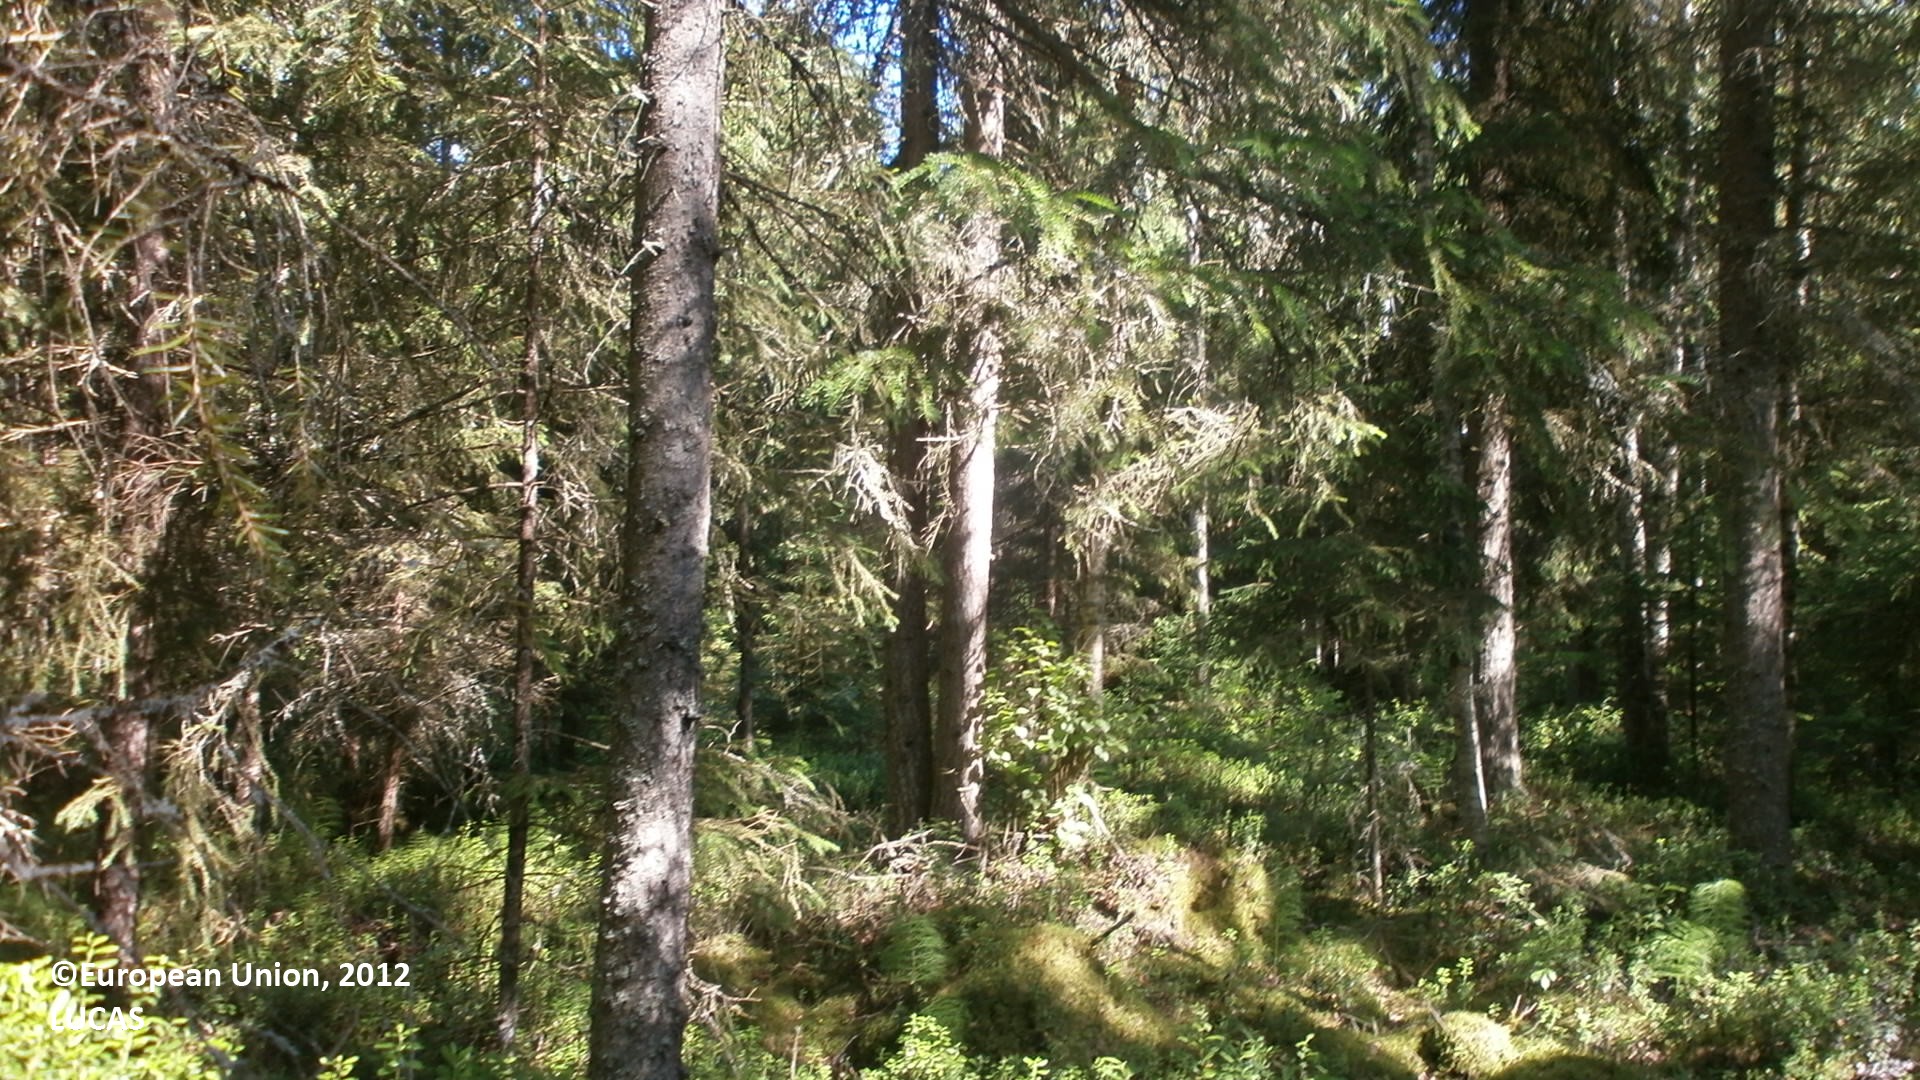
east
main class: Woodland
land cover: Spruce dominated coniferous woodland
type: boreal forest
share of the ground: > 75 %
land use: Forestry
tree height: > 5 m
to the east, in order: Spruce dominated coniferous woodland; Ditches and canals; Spruce dominated mixed woodland; Ditches and canals; Spruce dominated mixed woodland; Ditches and canals; Spruce dominated mixed woodland; Ditches and canals; Spruce dominated mixed woodland; Spruce dominated coniferous woodland; Broadleaved woodland; Spruce dominated mixed woodland
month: July
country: FI
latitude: 64.3307
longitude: 23.9443
